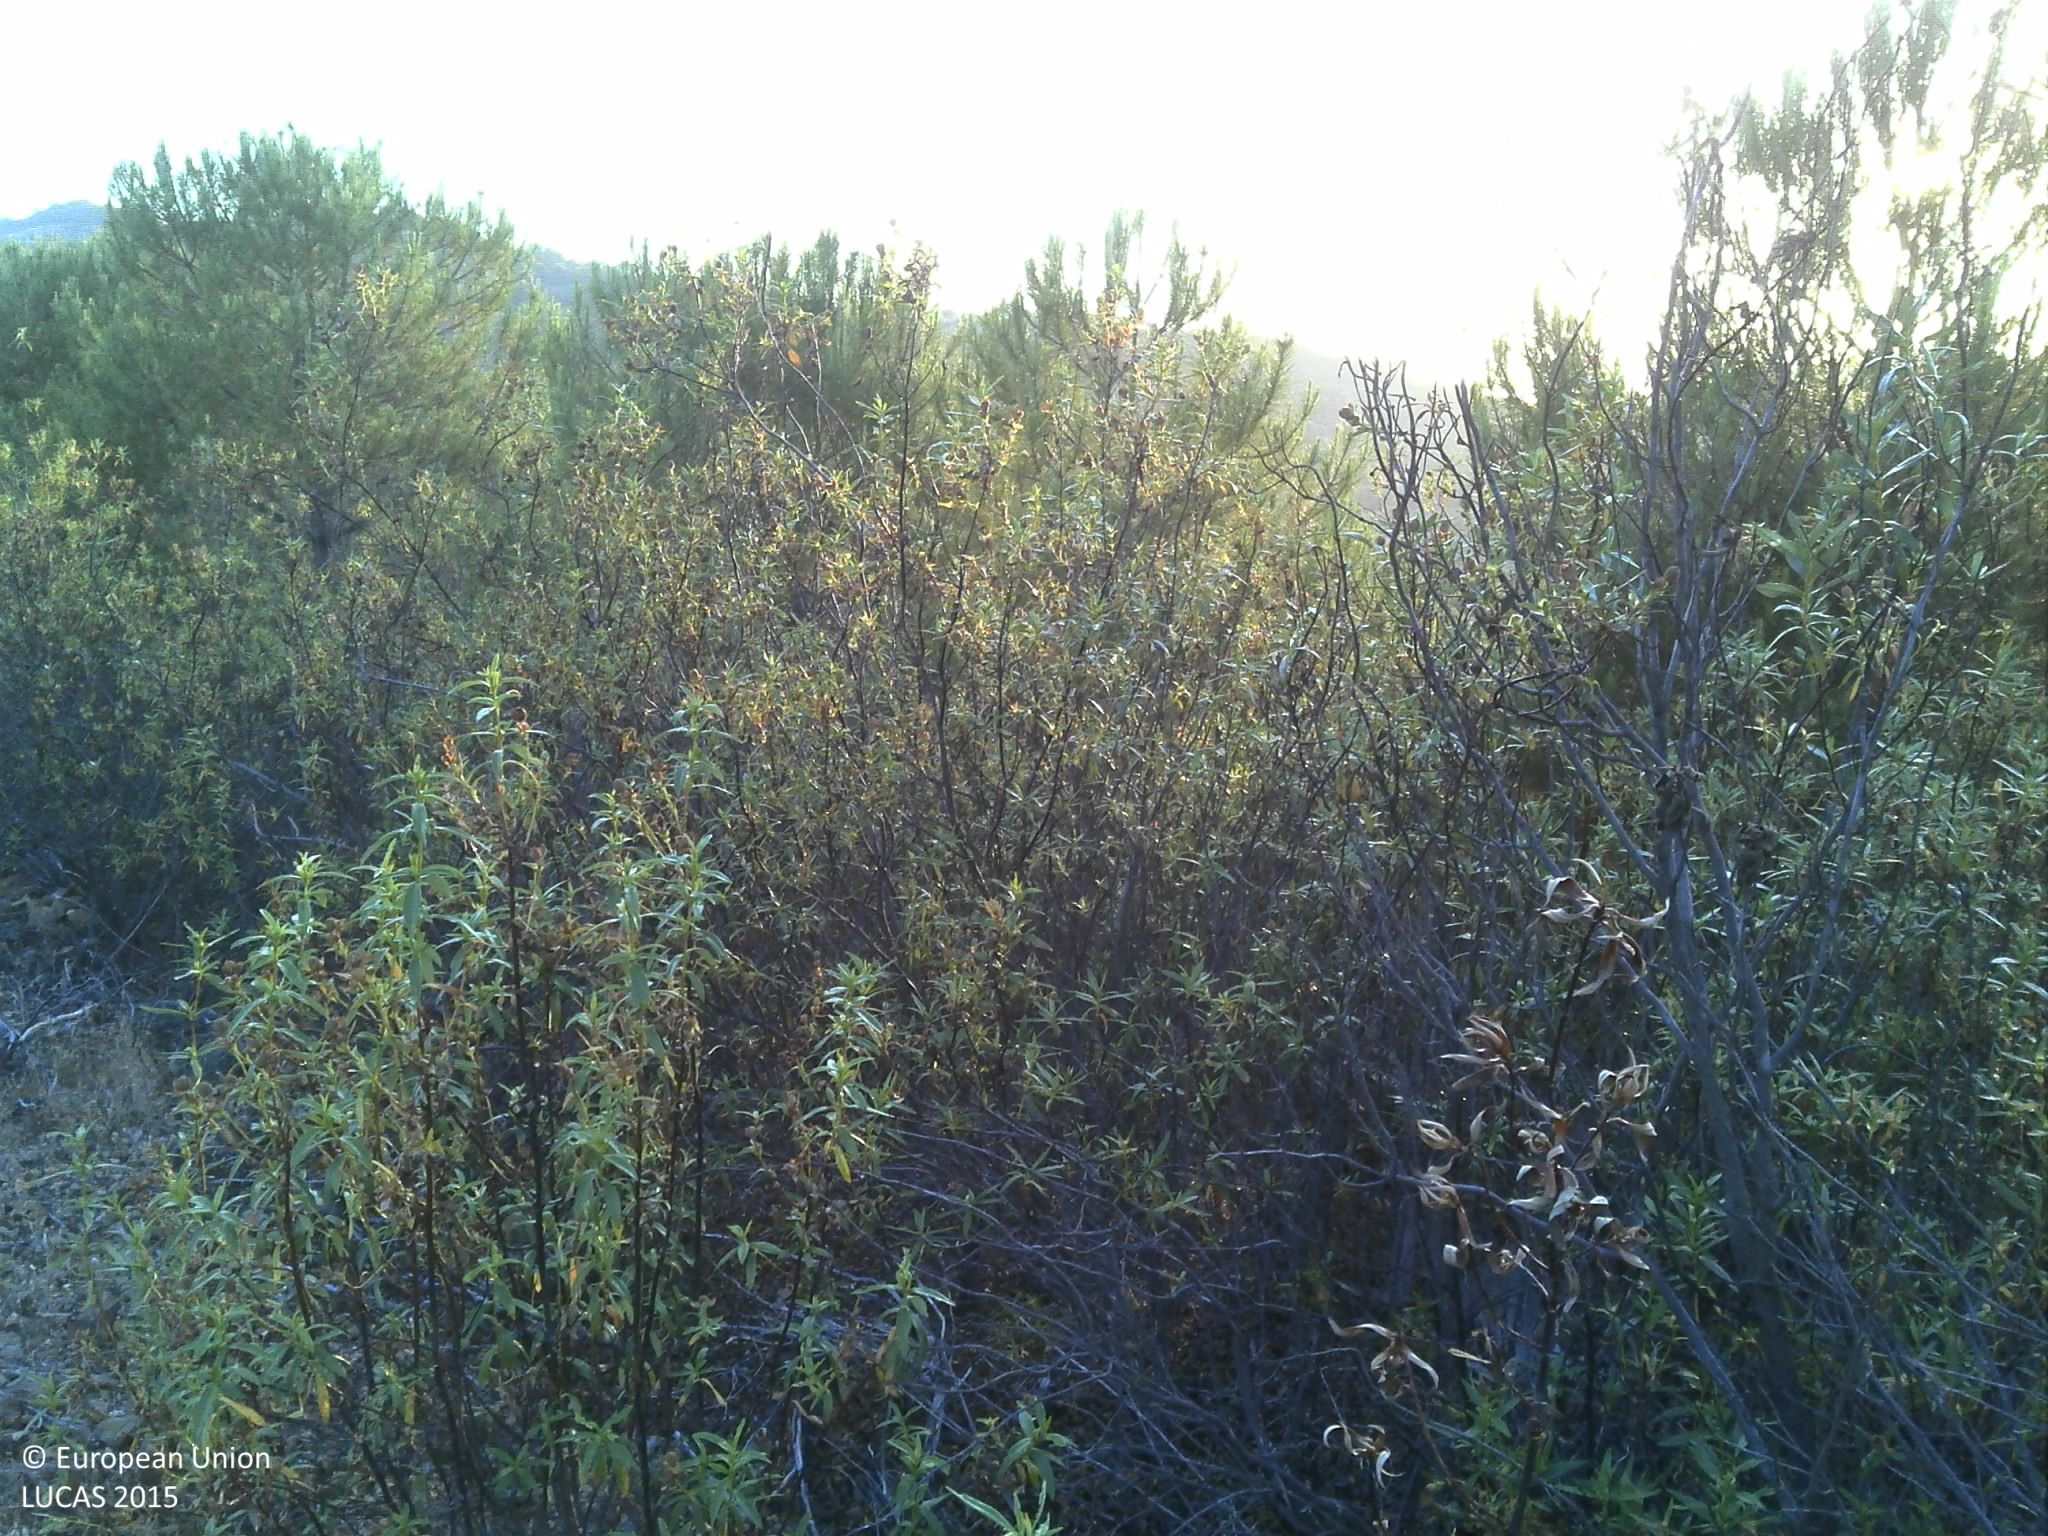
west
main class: Woodland
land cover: Pine dominated coniferous woodland
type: coniferous forest of the mediterranean region
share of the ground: 50 - 75 %
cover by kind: shrubs 65 %, coniferous forest trees 35 %
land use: Forestry
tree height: < 5 m
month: May
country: PT
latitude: 37.3982
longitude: -7.7360
